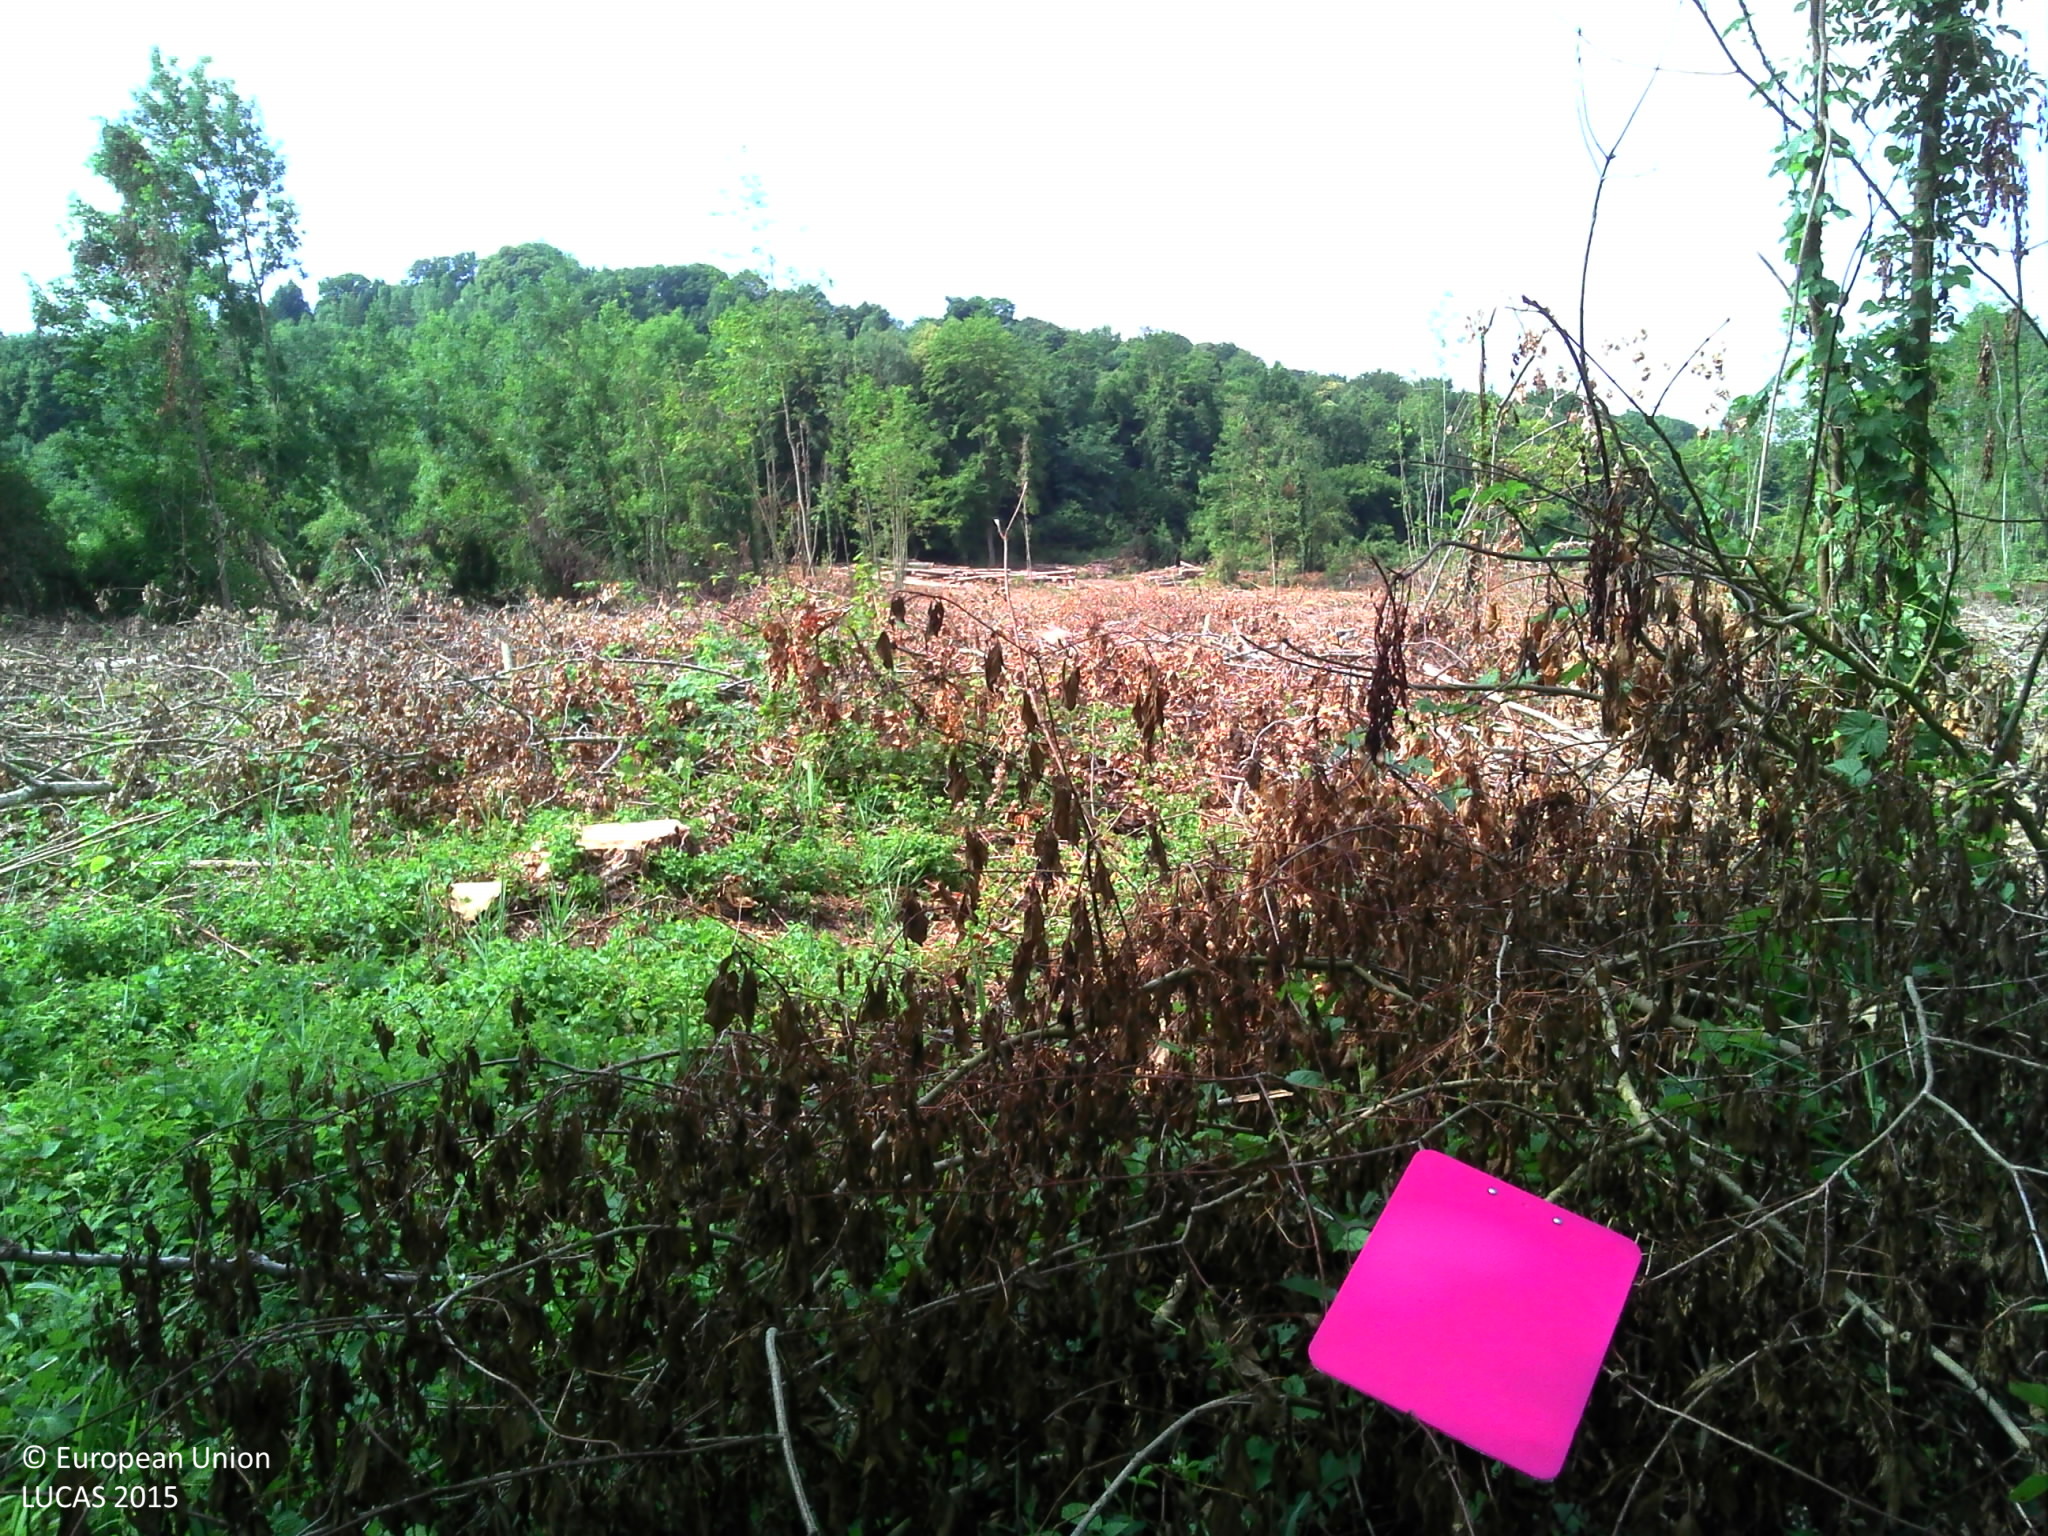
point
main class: Woodland
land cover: Broadleaved woodland
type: mesophytic deciduous forest
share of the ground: > 75 %
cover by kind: broadleaved forest trees 35 %, herbaceous plants 35 %, shrubs 30 %
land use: Forestry
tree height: > 5 m
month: July
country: FR
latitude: 49.3025
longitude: 2.4653
